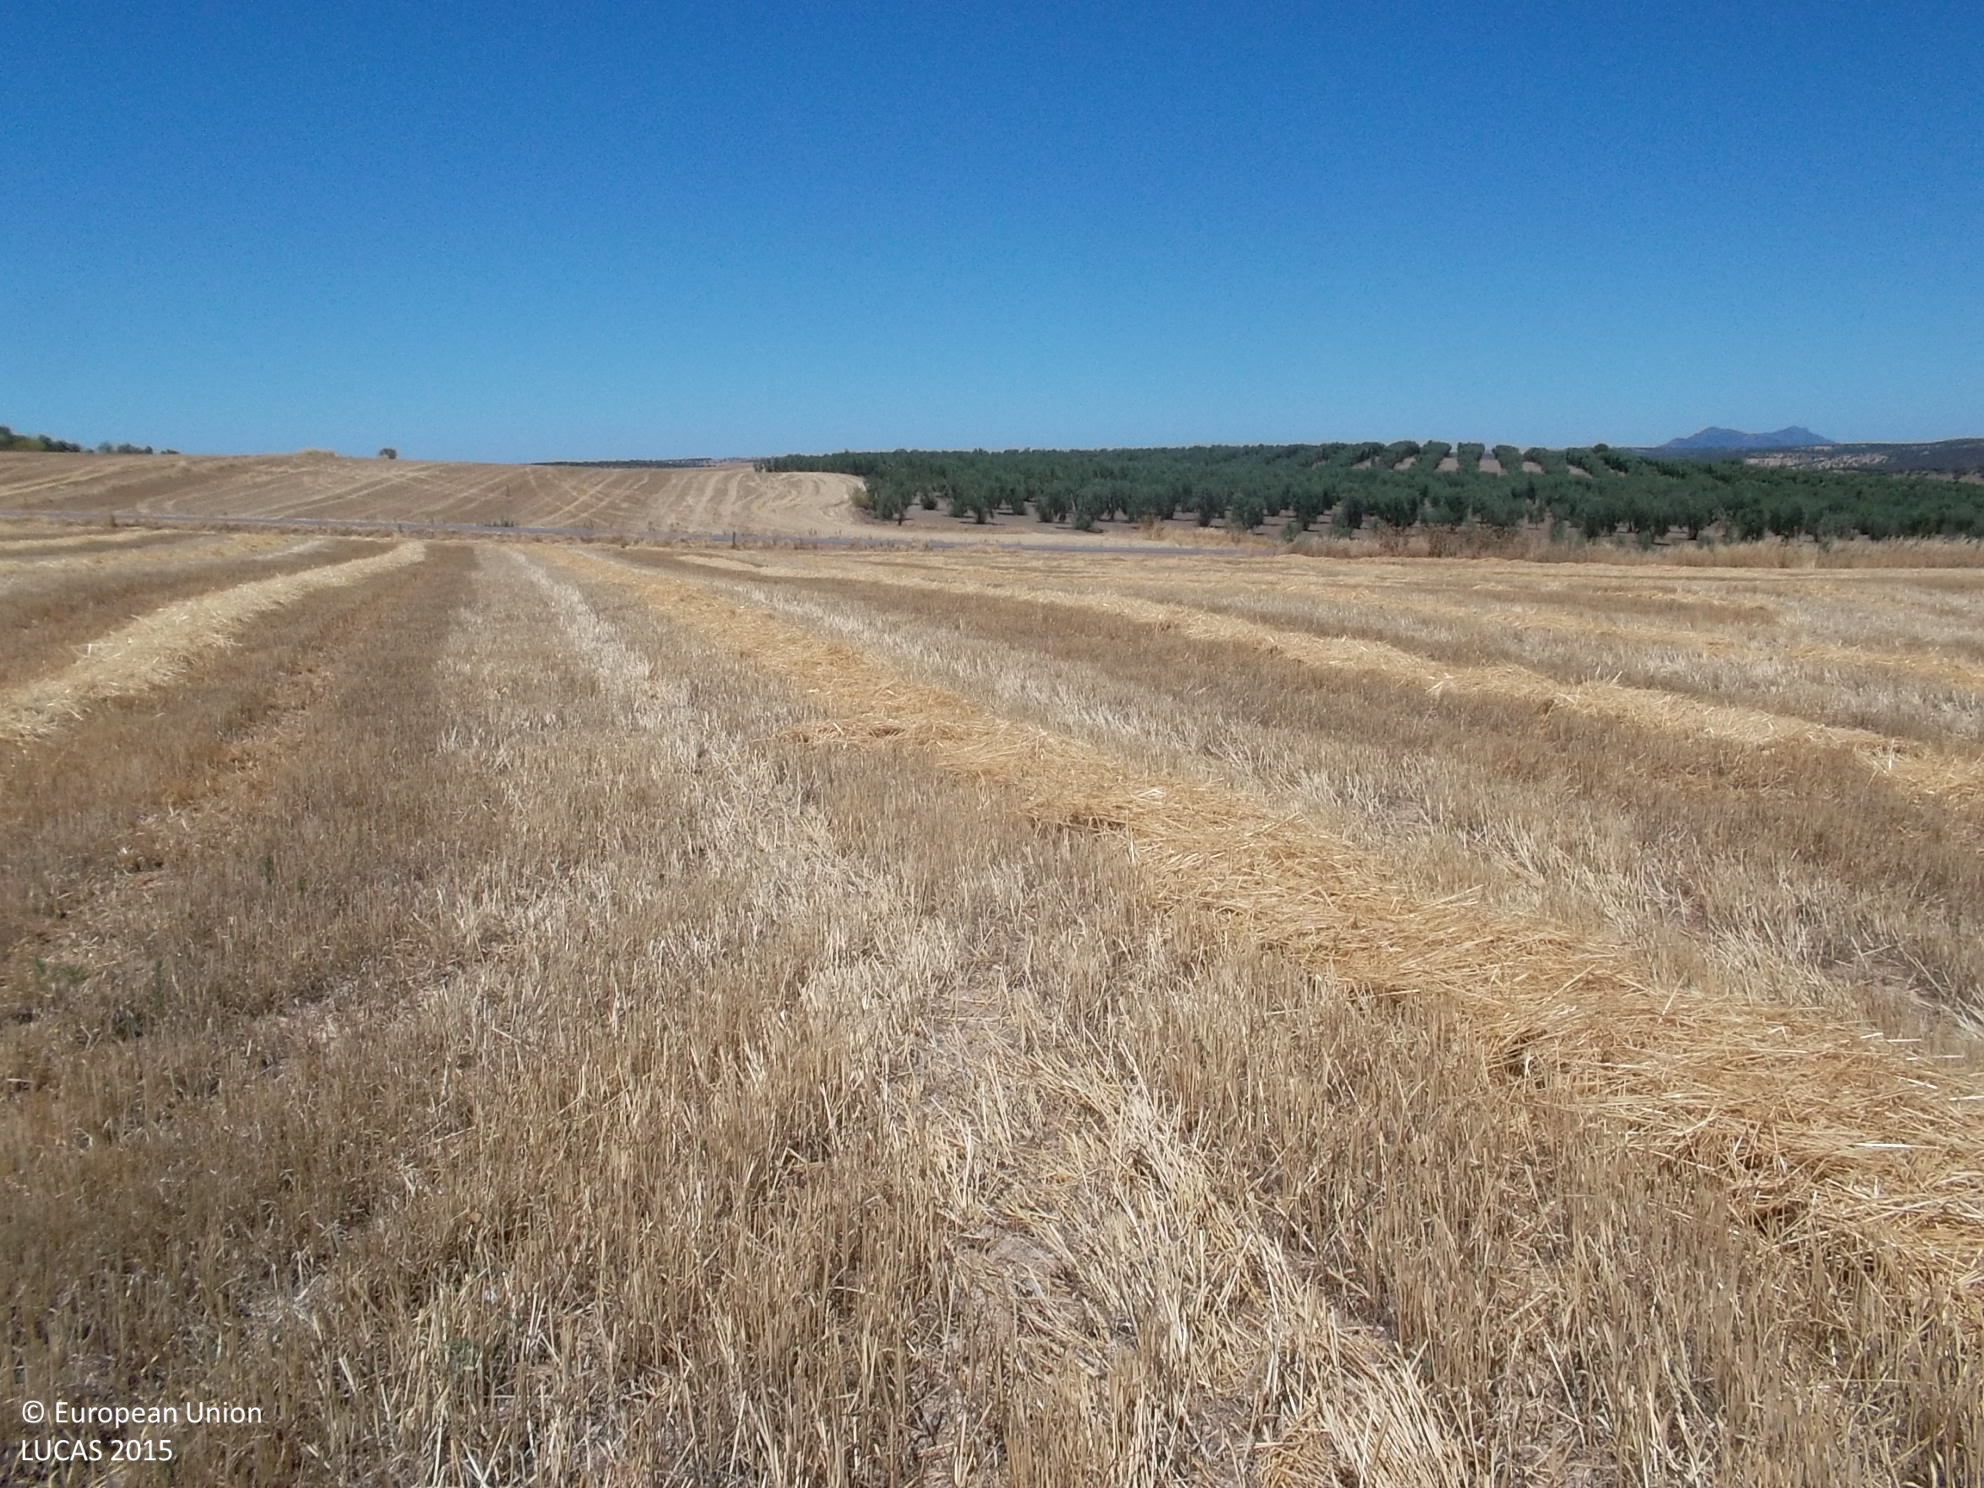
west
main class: Cropland
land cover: Common wheat
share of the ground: < 10 %
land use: Agriculture (excluding fallow land and kitchen gardens)
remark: Harvested field
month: July
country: ES
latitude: 38.3847
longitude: -5.8259
